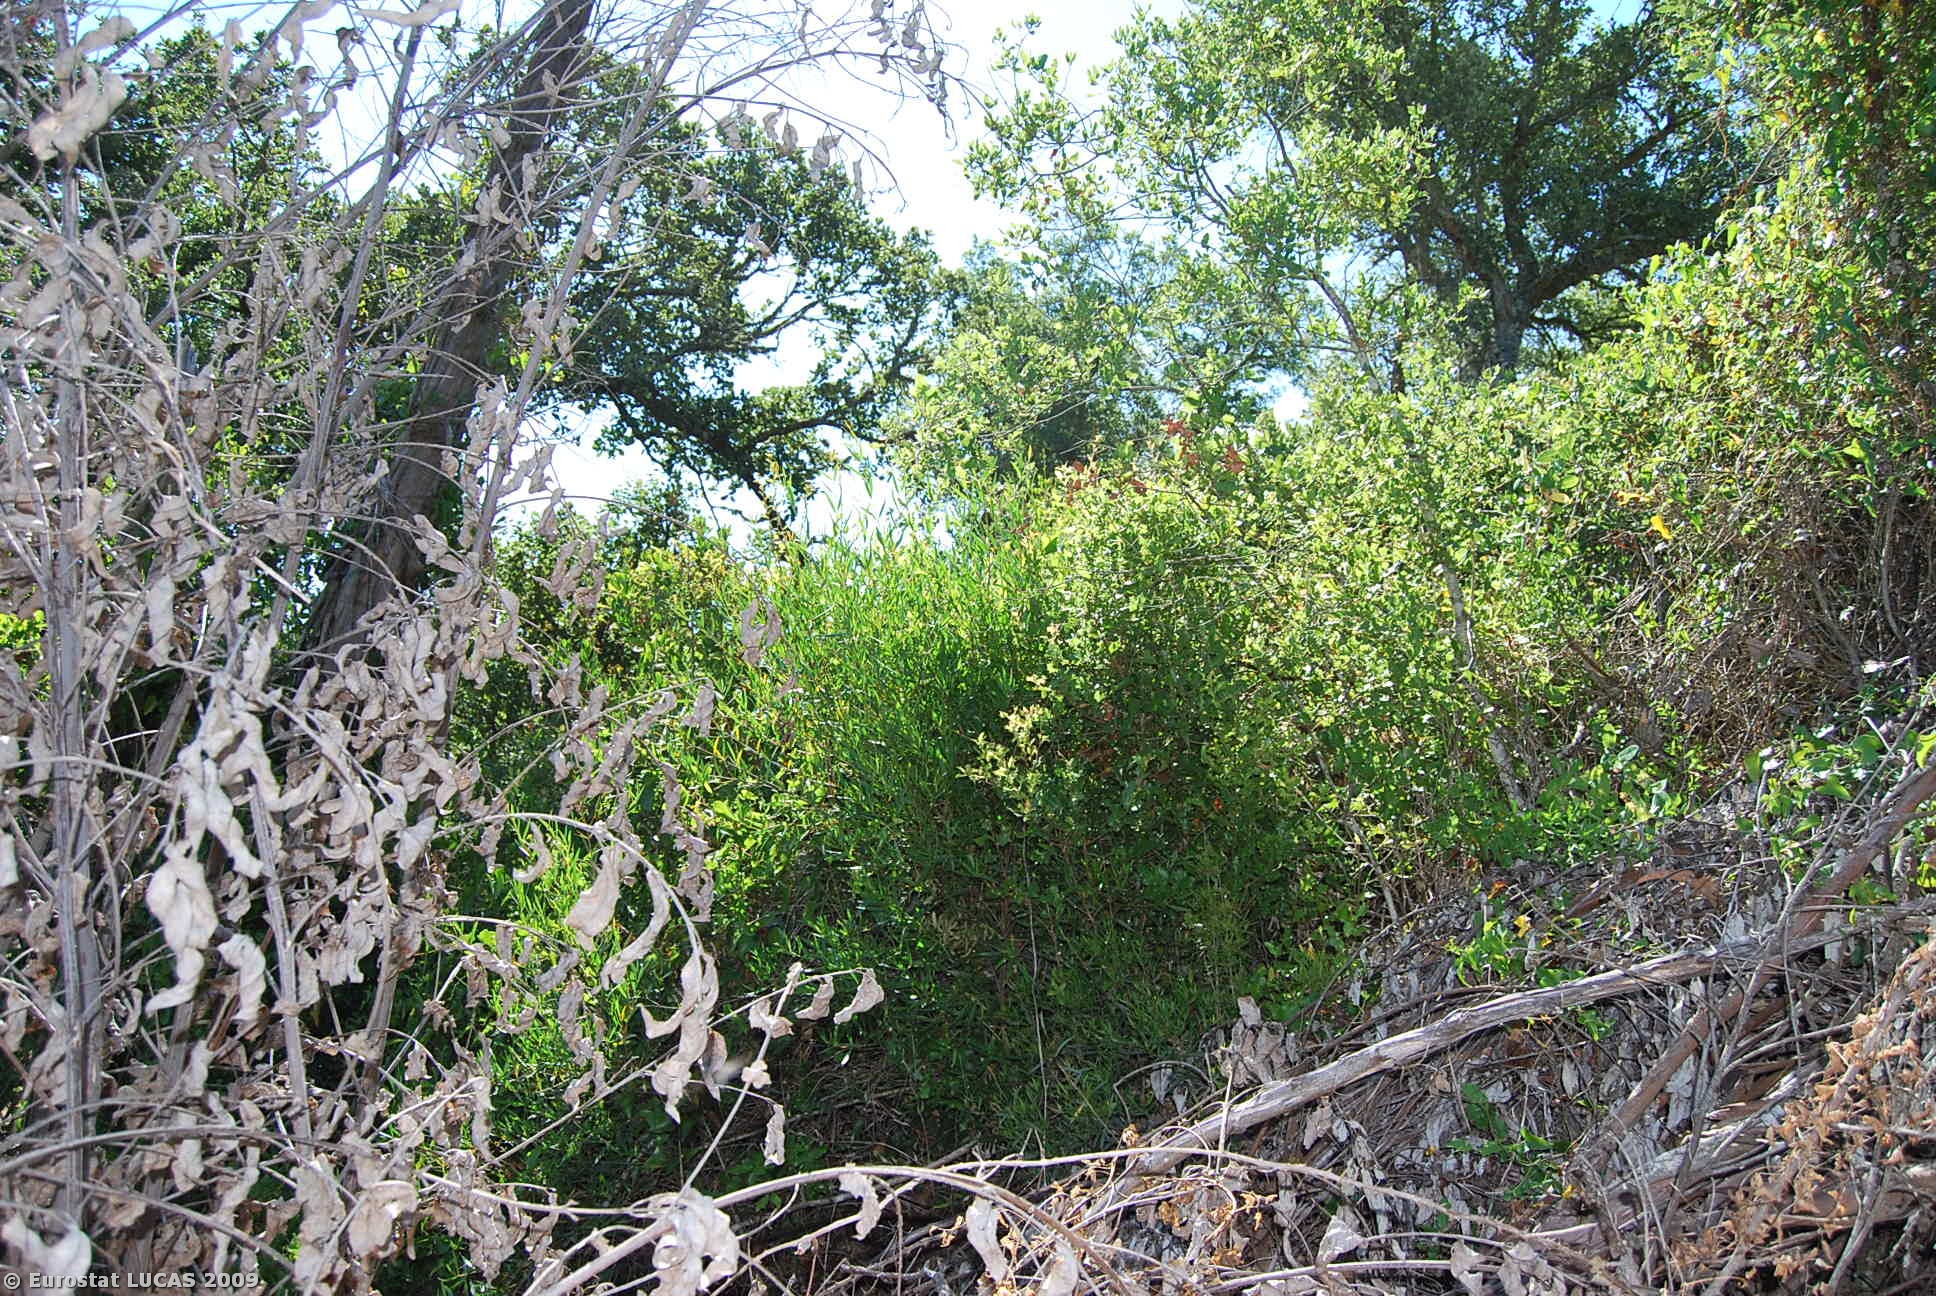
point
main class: Woodland
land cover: Broadleaved woodland
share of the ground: 25 - 50 %
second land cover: Shrubland with sparse tree cover
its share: 50 - 75 %
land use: Unused
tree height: < 5 m
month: June
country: PT
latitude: 37.9599
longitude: -8.5619
